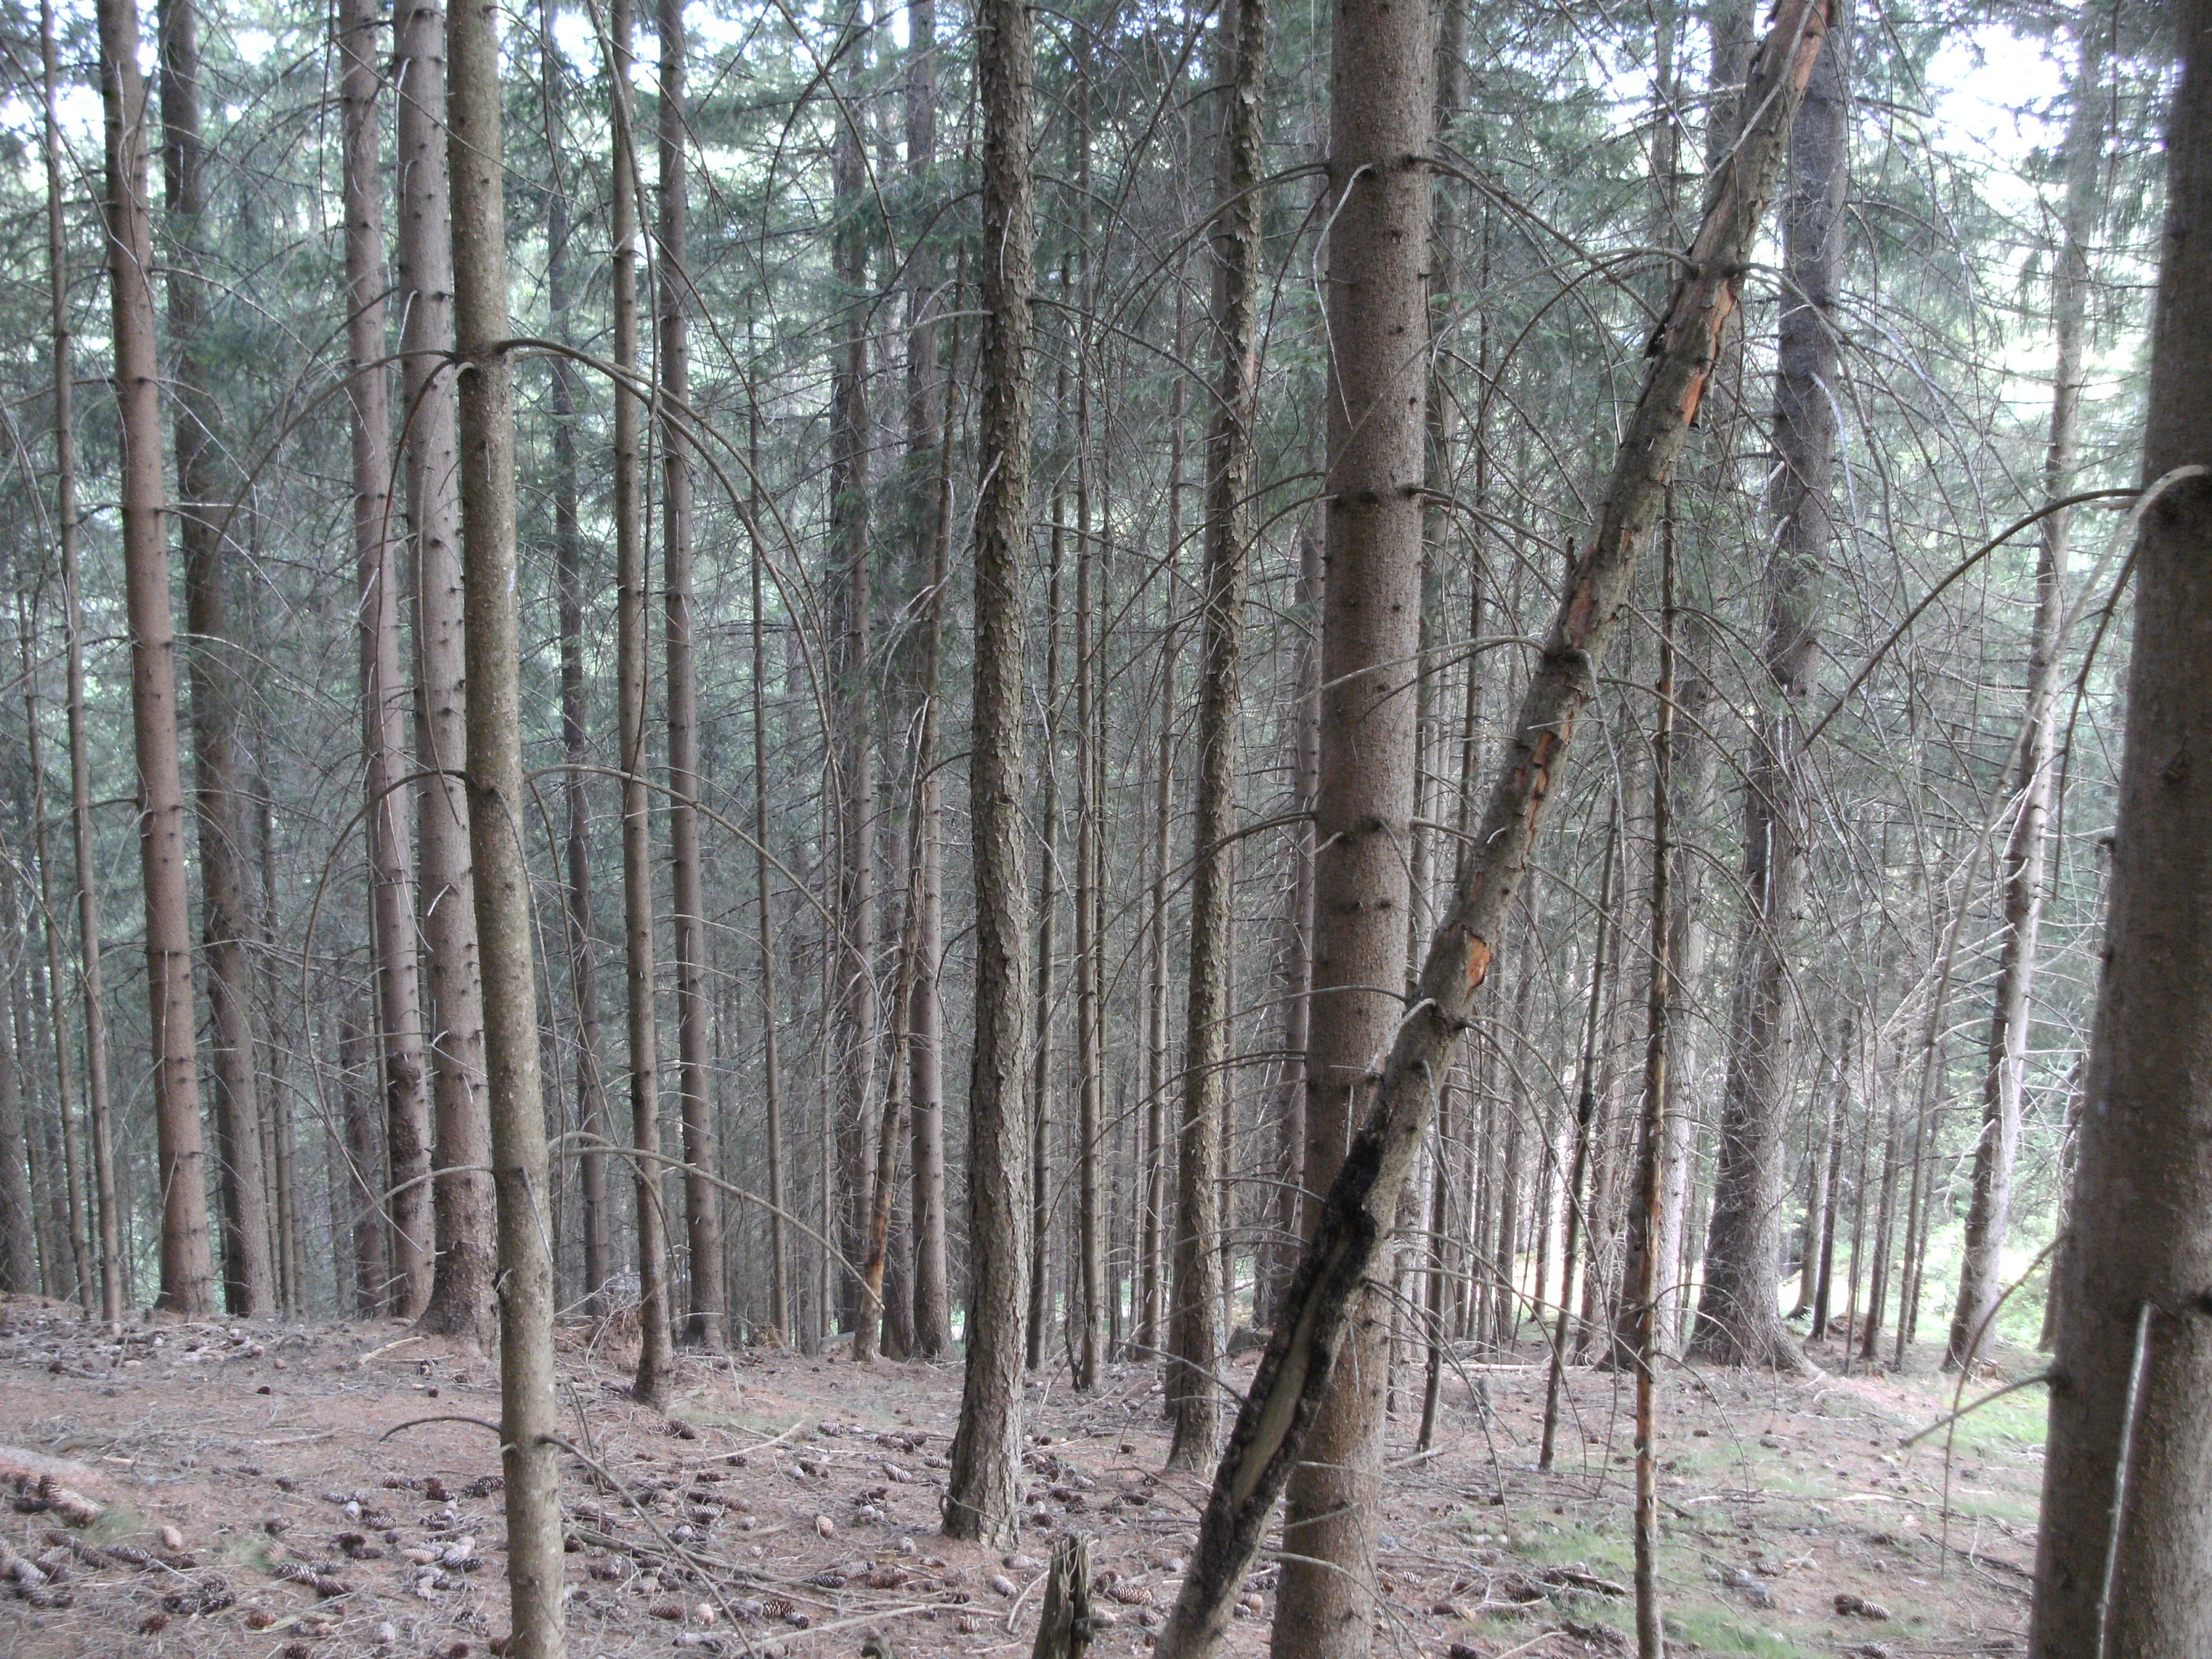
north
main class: Woodland
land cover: Spruce dominated coniferous woodland
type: hemiboreal forest and nemoral coniferous forest and mixed broadleaved-coniferous forest
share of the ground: > 75 %
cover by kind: coniferous forest trees 90 %, unconsolidated bare surface 10 %
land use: Forestry
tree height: > 5 m
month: July
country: AT
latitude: 47.0046
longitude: 14.7202
